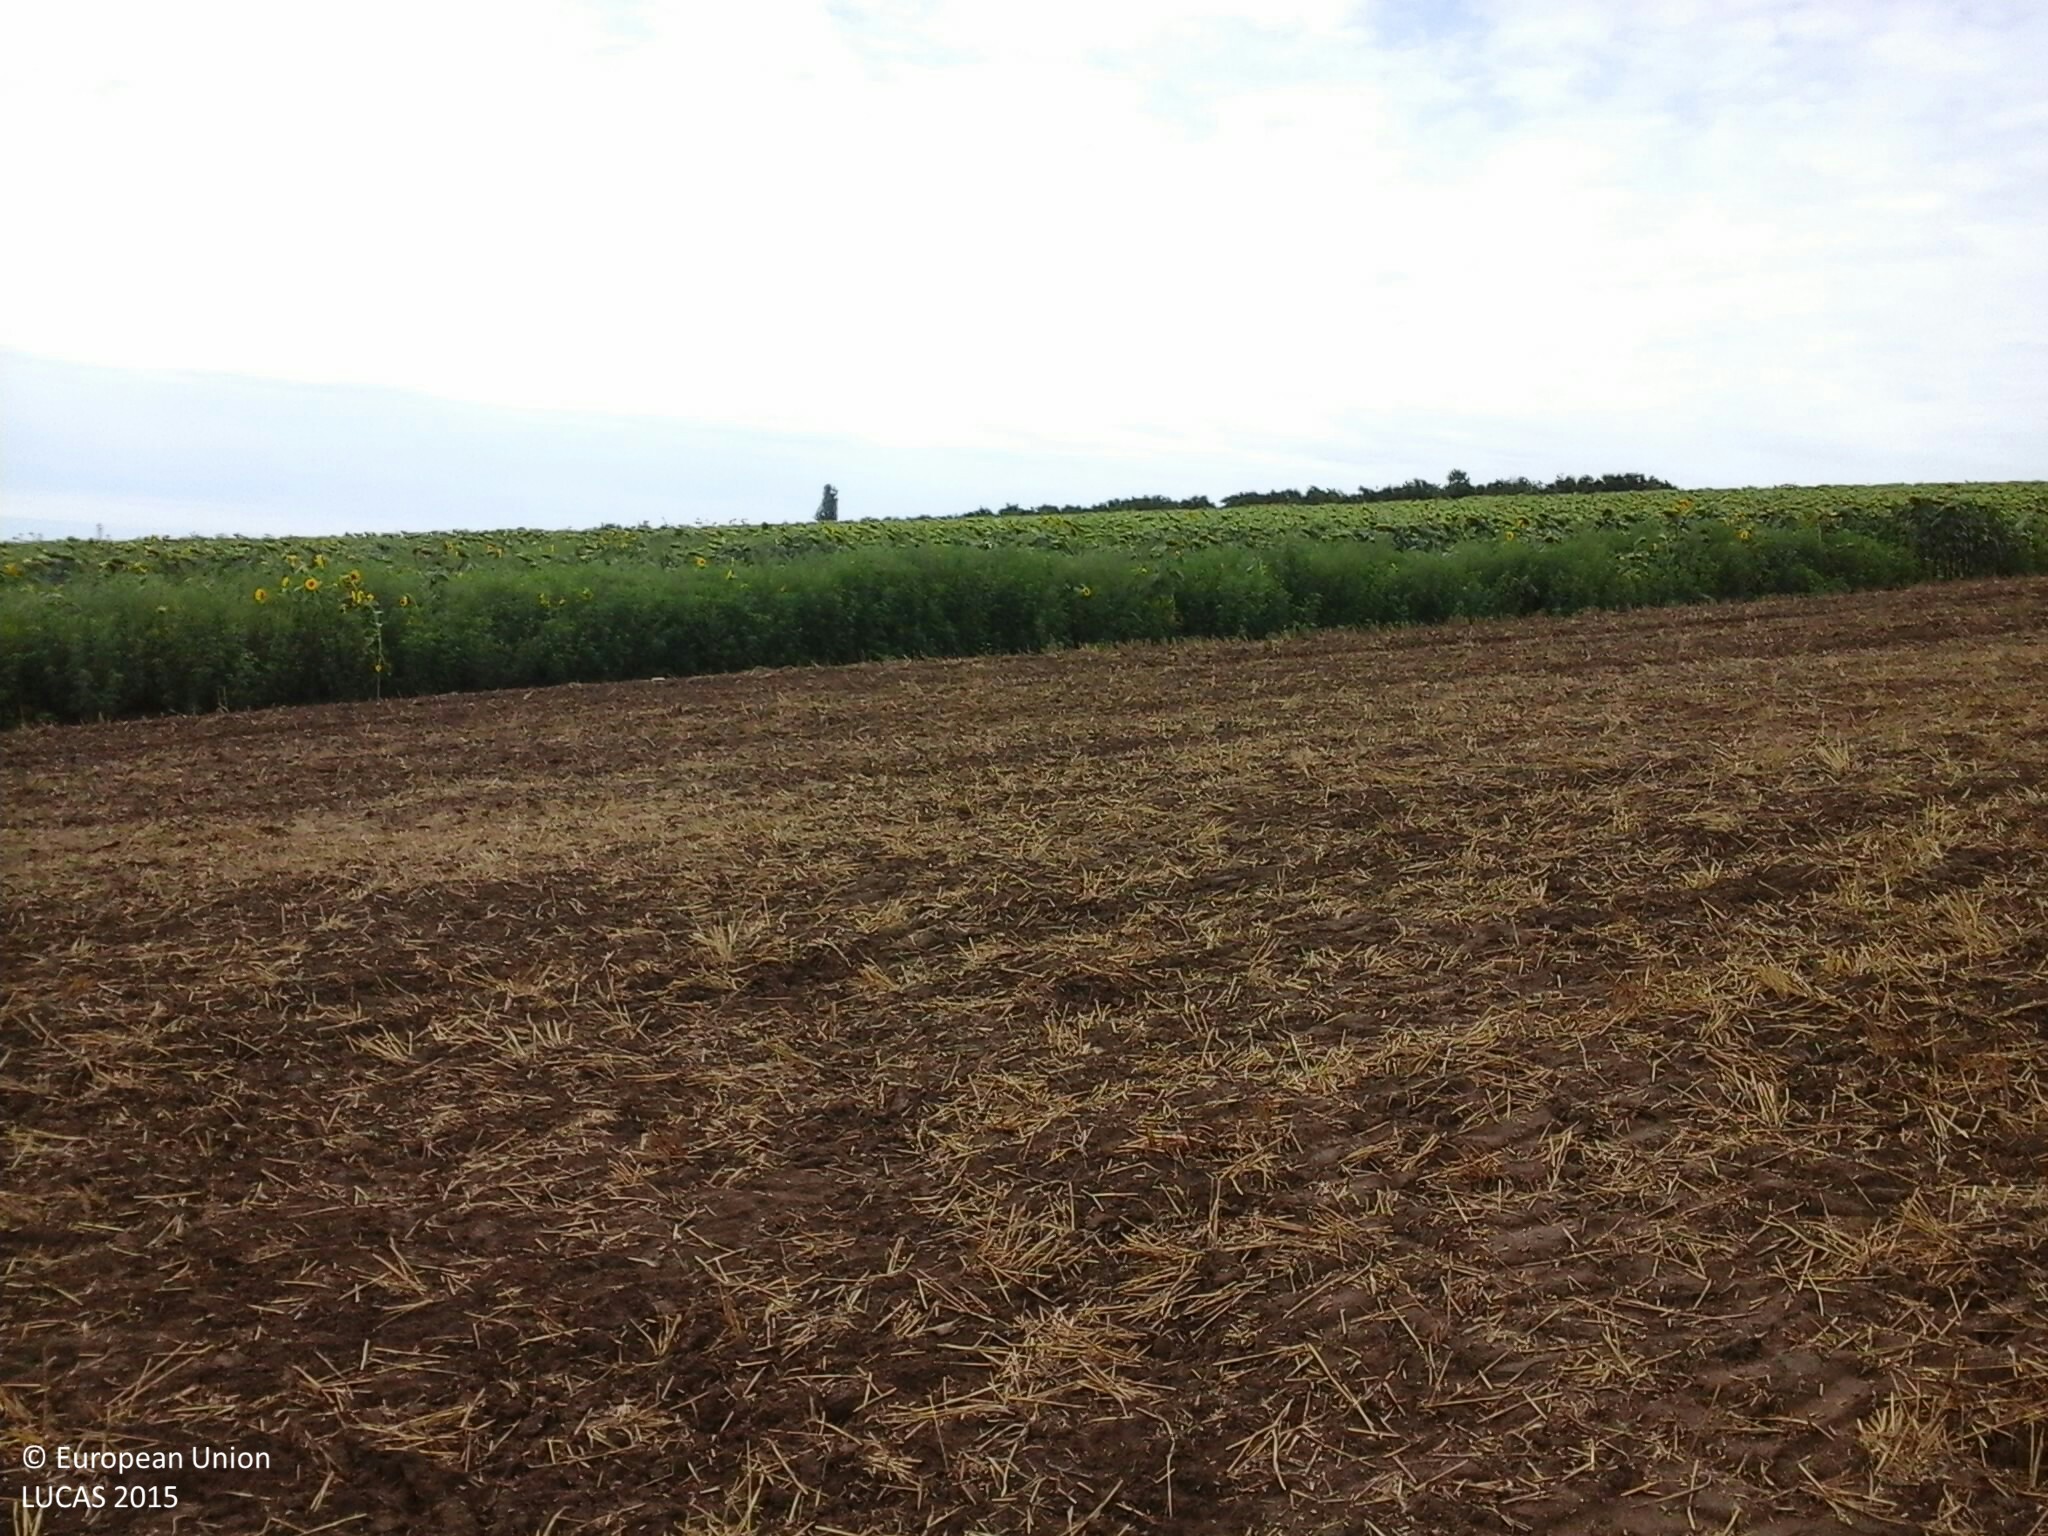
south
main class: Cropland
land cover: Common wheat
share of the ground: < 10 %
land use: Agriculture (excluding fallow land and kitchen gardens)
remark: Harvested field
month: July
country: HU
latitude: 46.6567
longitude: 17.8873
